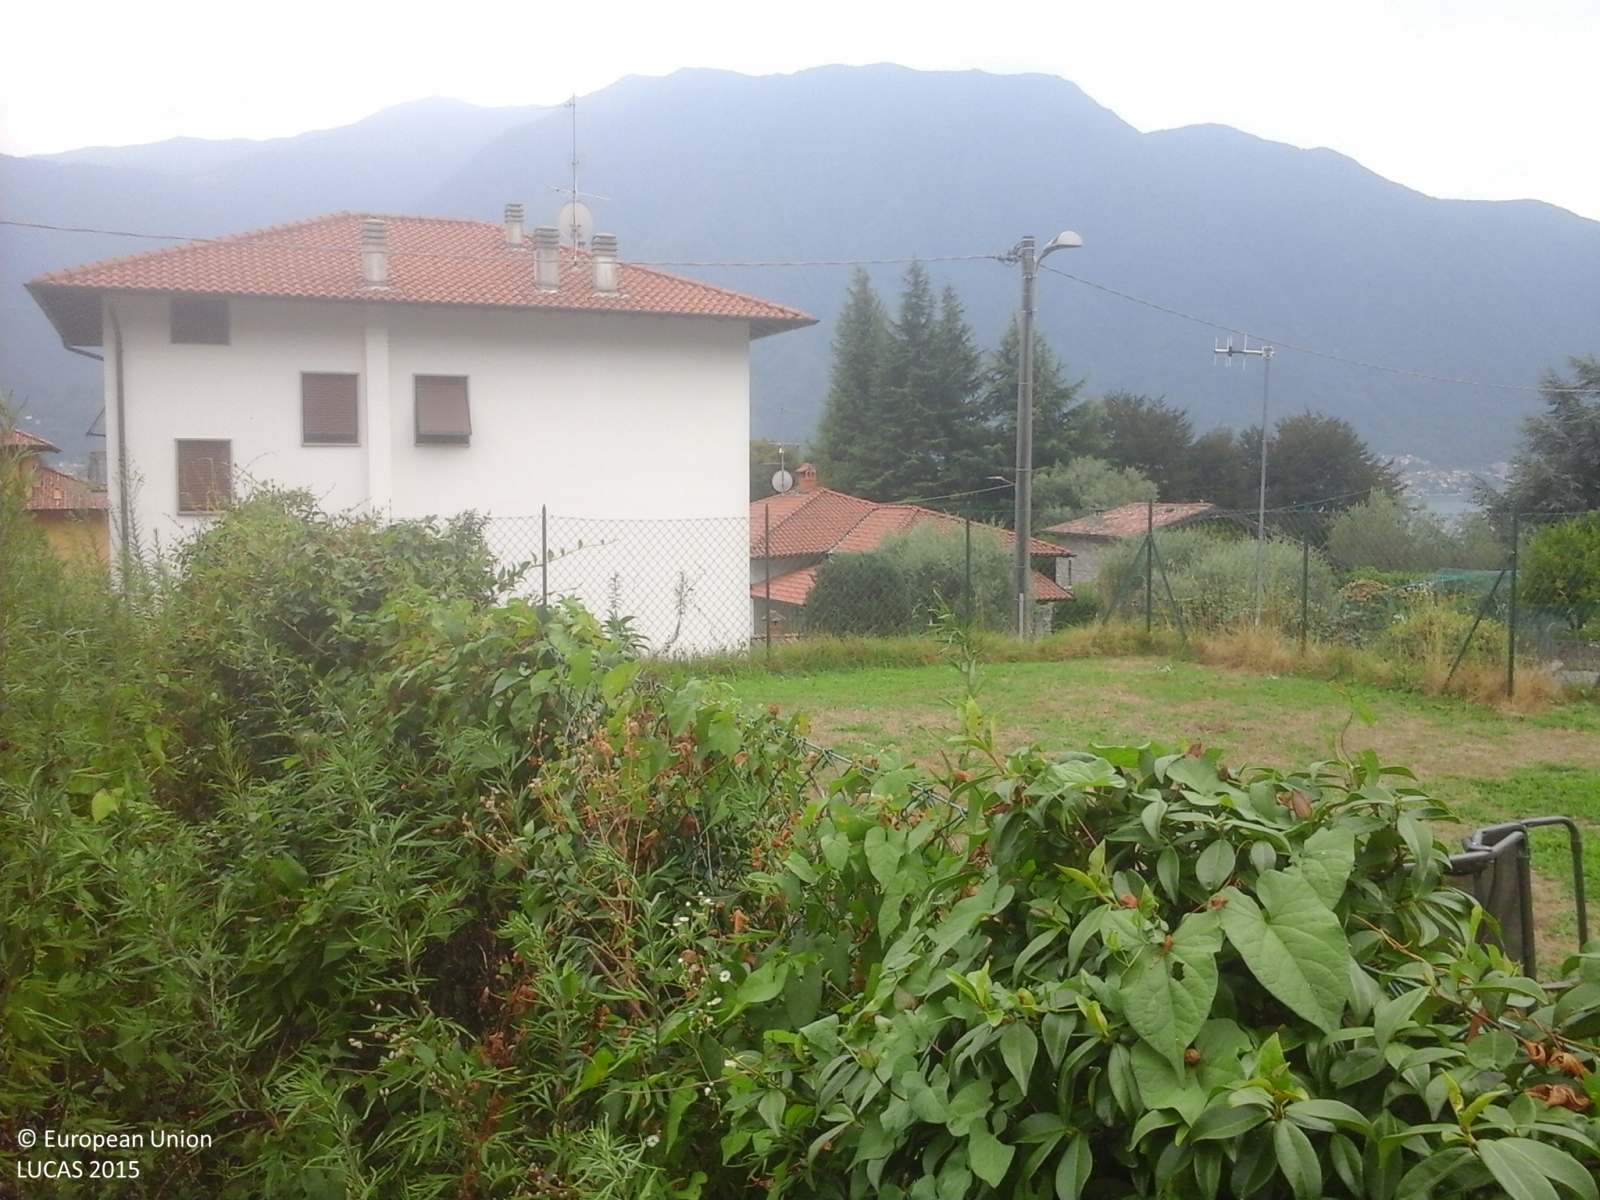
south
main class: Grassland
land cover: Grassland without tree/shrub cover
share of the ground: > 75 %
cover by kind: herbaceous plants 100 %
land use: Residential
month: August
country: IT
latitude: 45.9698
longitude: 9.1882
